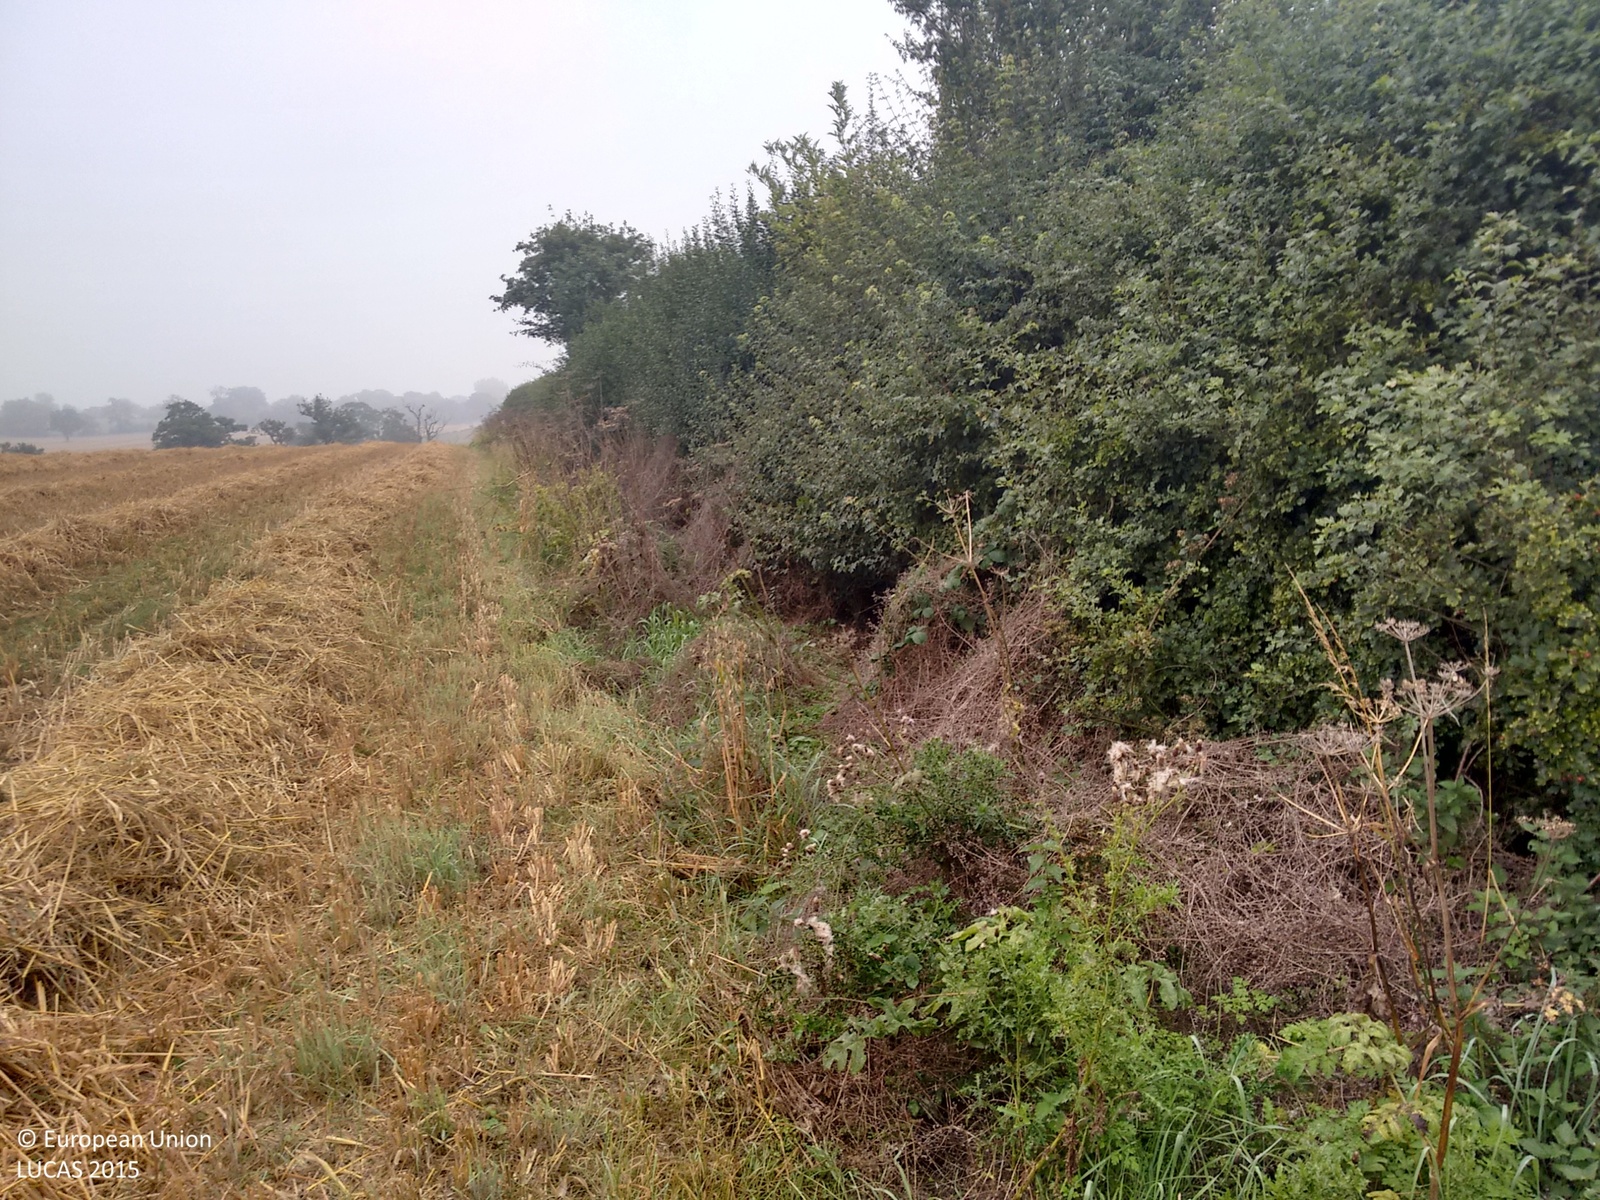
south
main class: Cropland
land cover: Maize
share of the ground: > 75 %
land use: Agriculture (excluding fallow land and kitchen gardens)
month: September
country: GB
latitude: 52.6610
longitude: -2.8313
